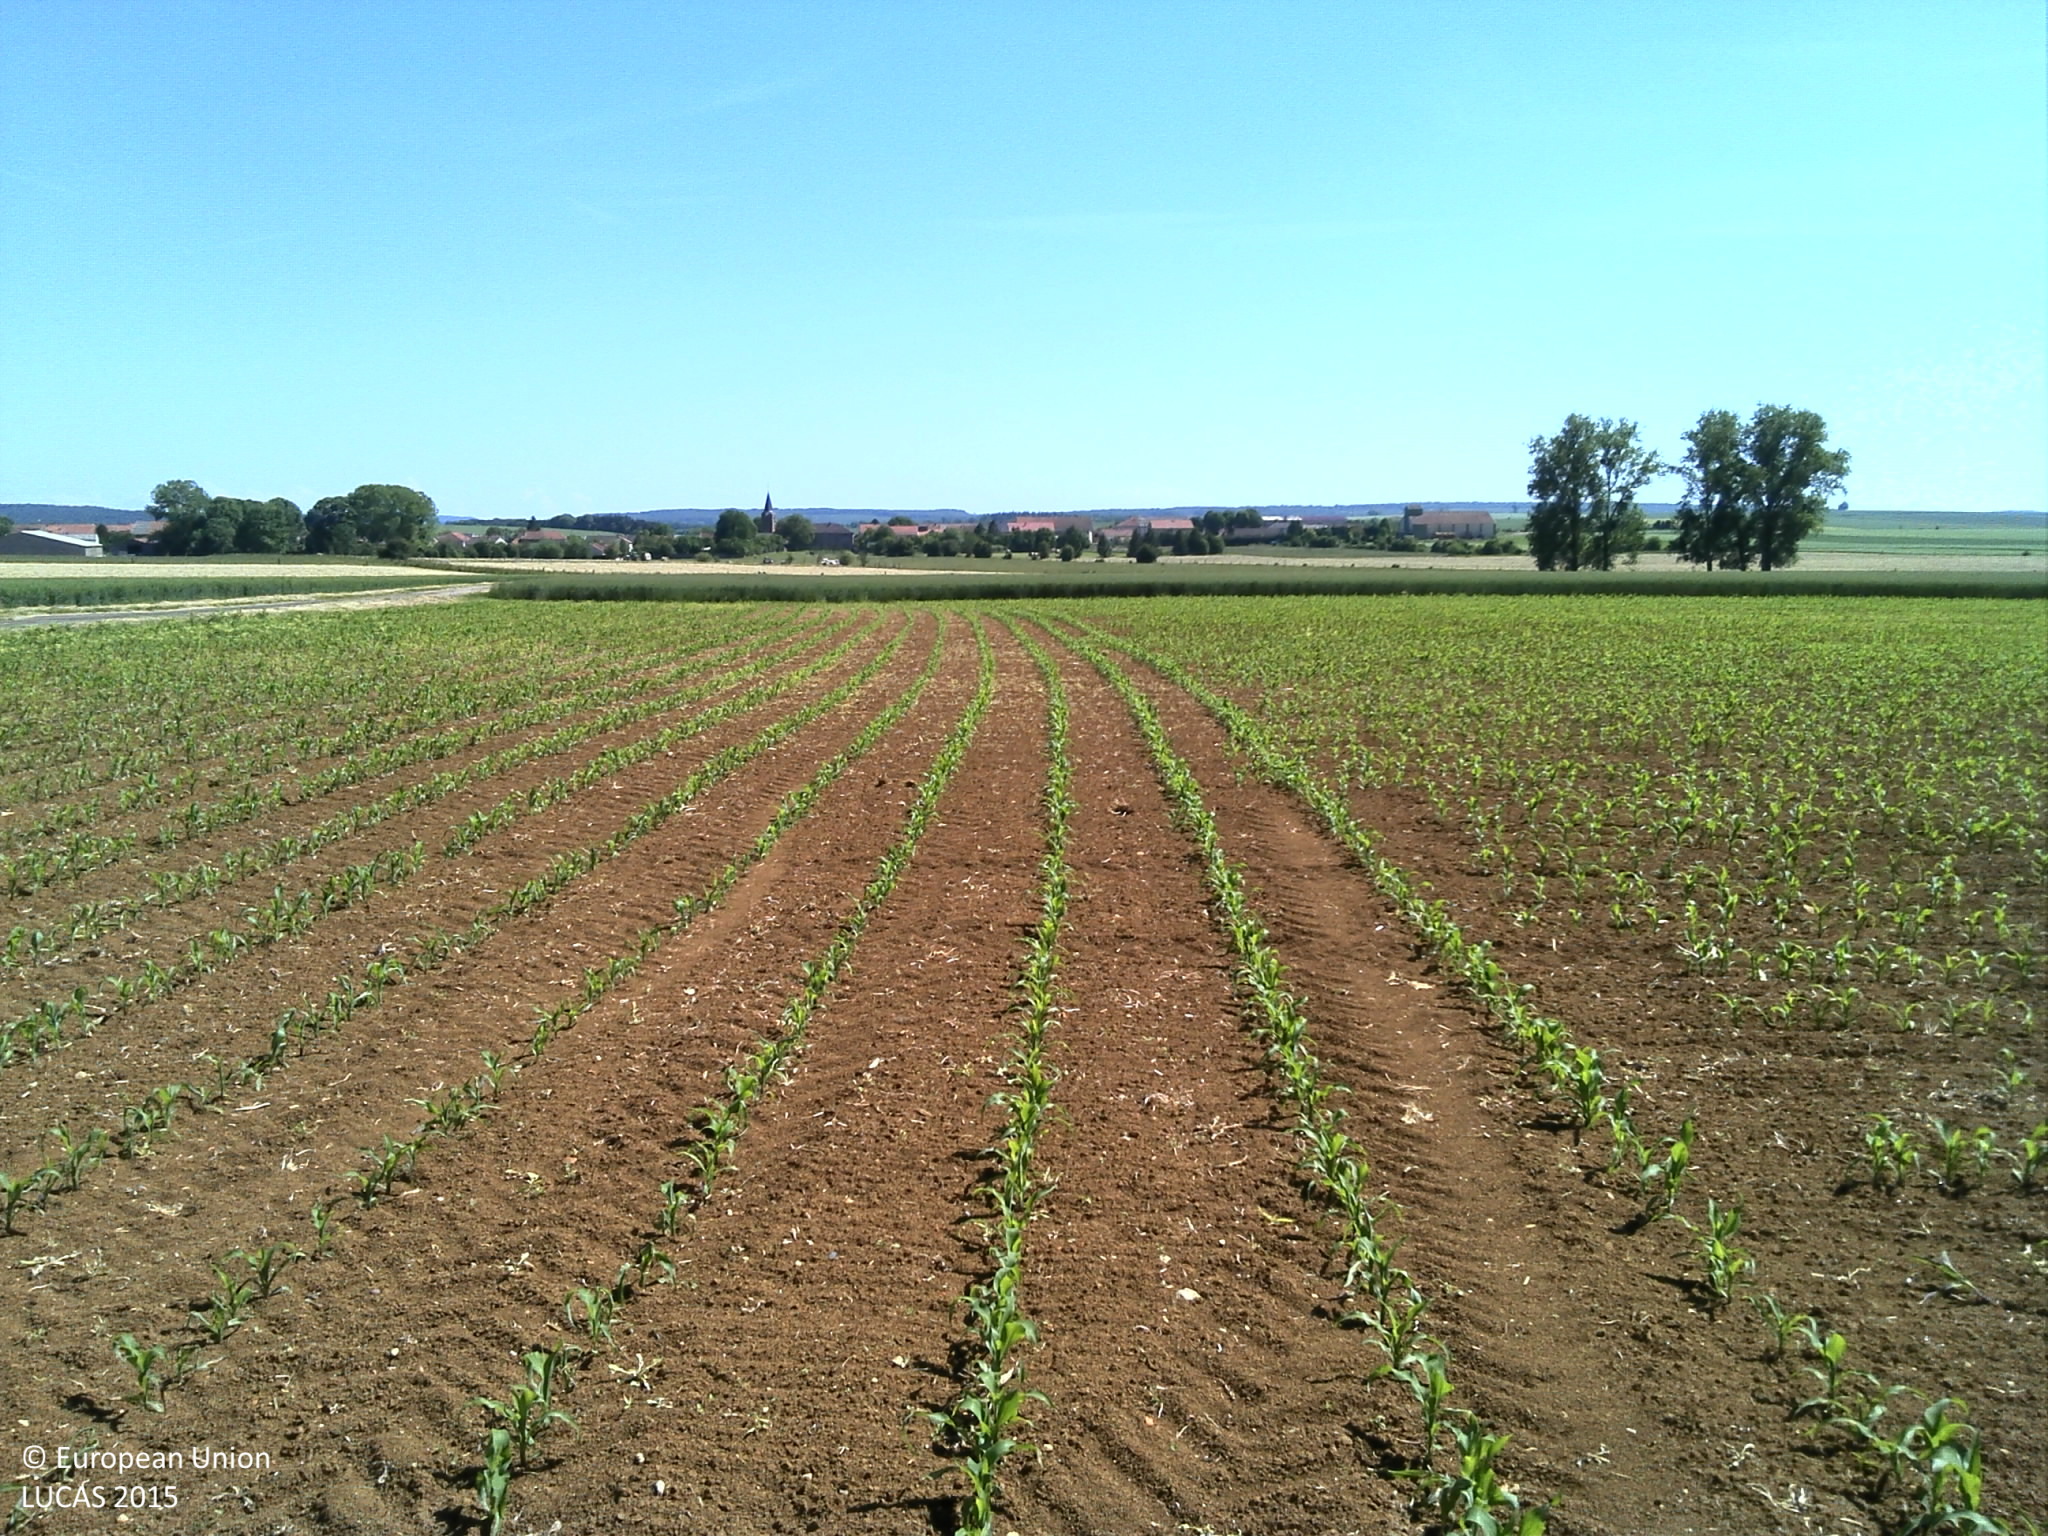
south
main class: Cropland
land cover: Maize
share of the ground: < 10 %
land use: Agriculture (excluding fallow land and kitchen gardens)
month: June
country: FR
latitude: 49.1052
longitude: 5.9860
